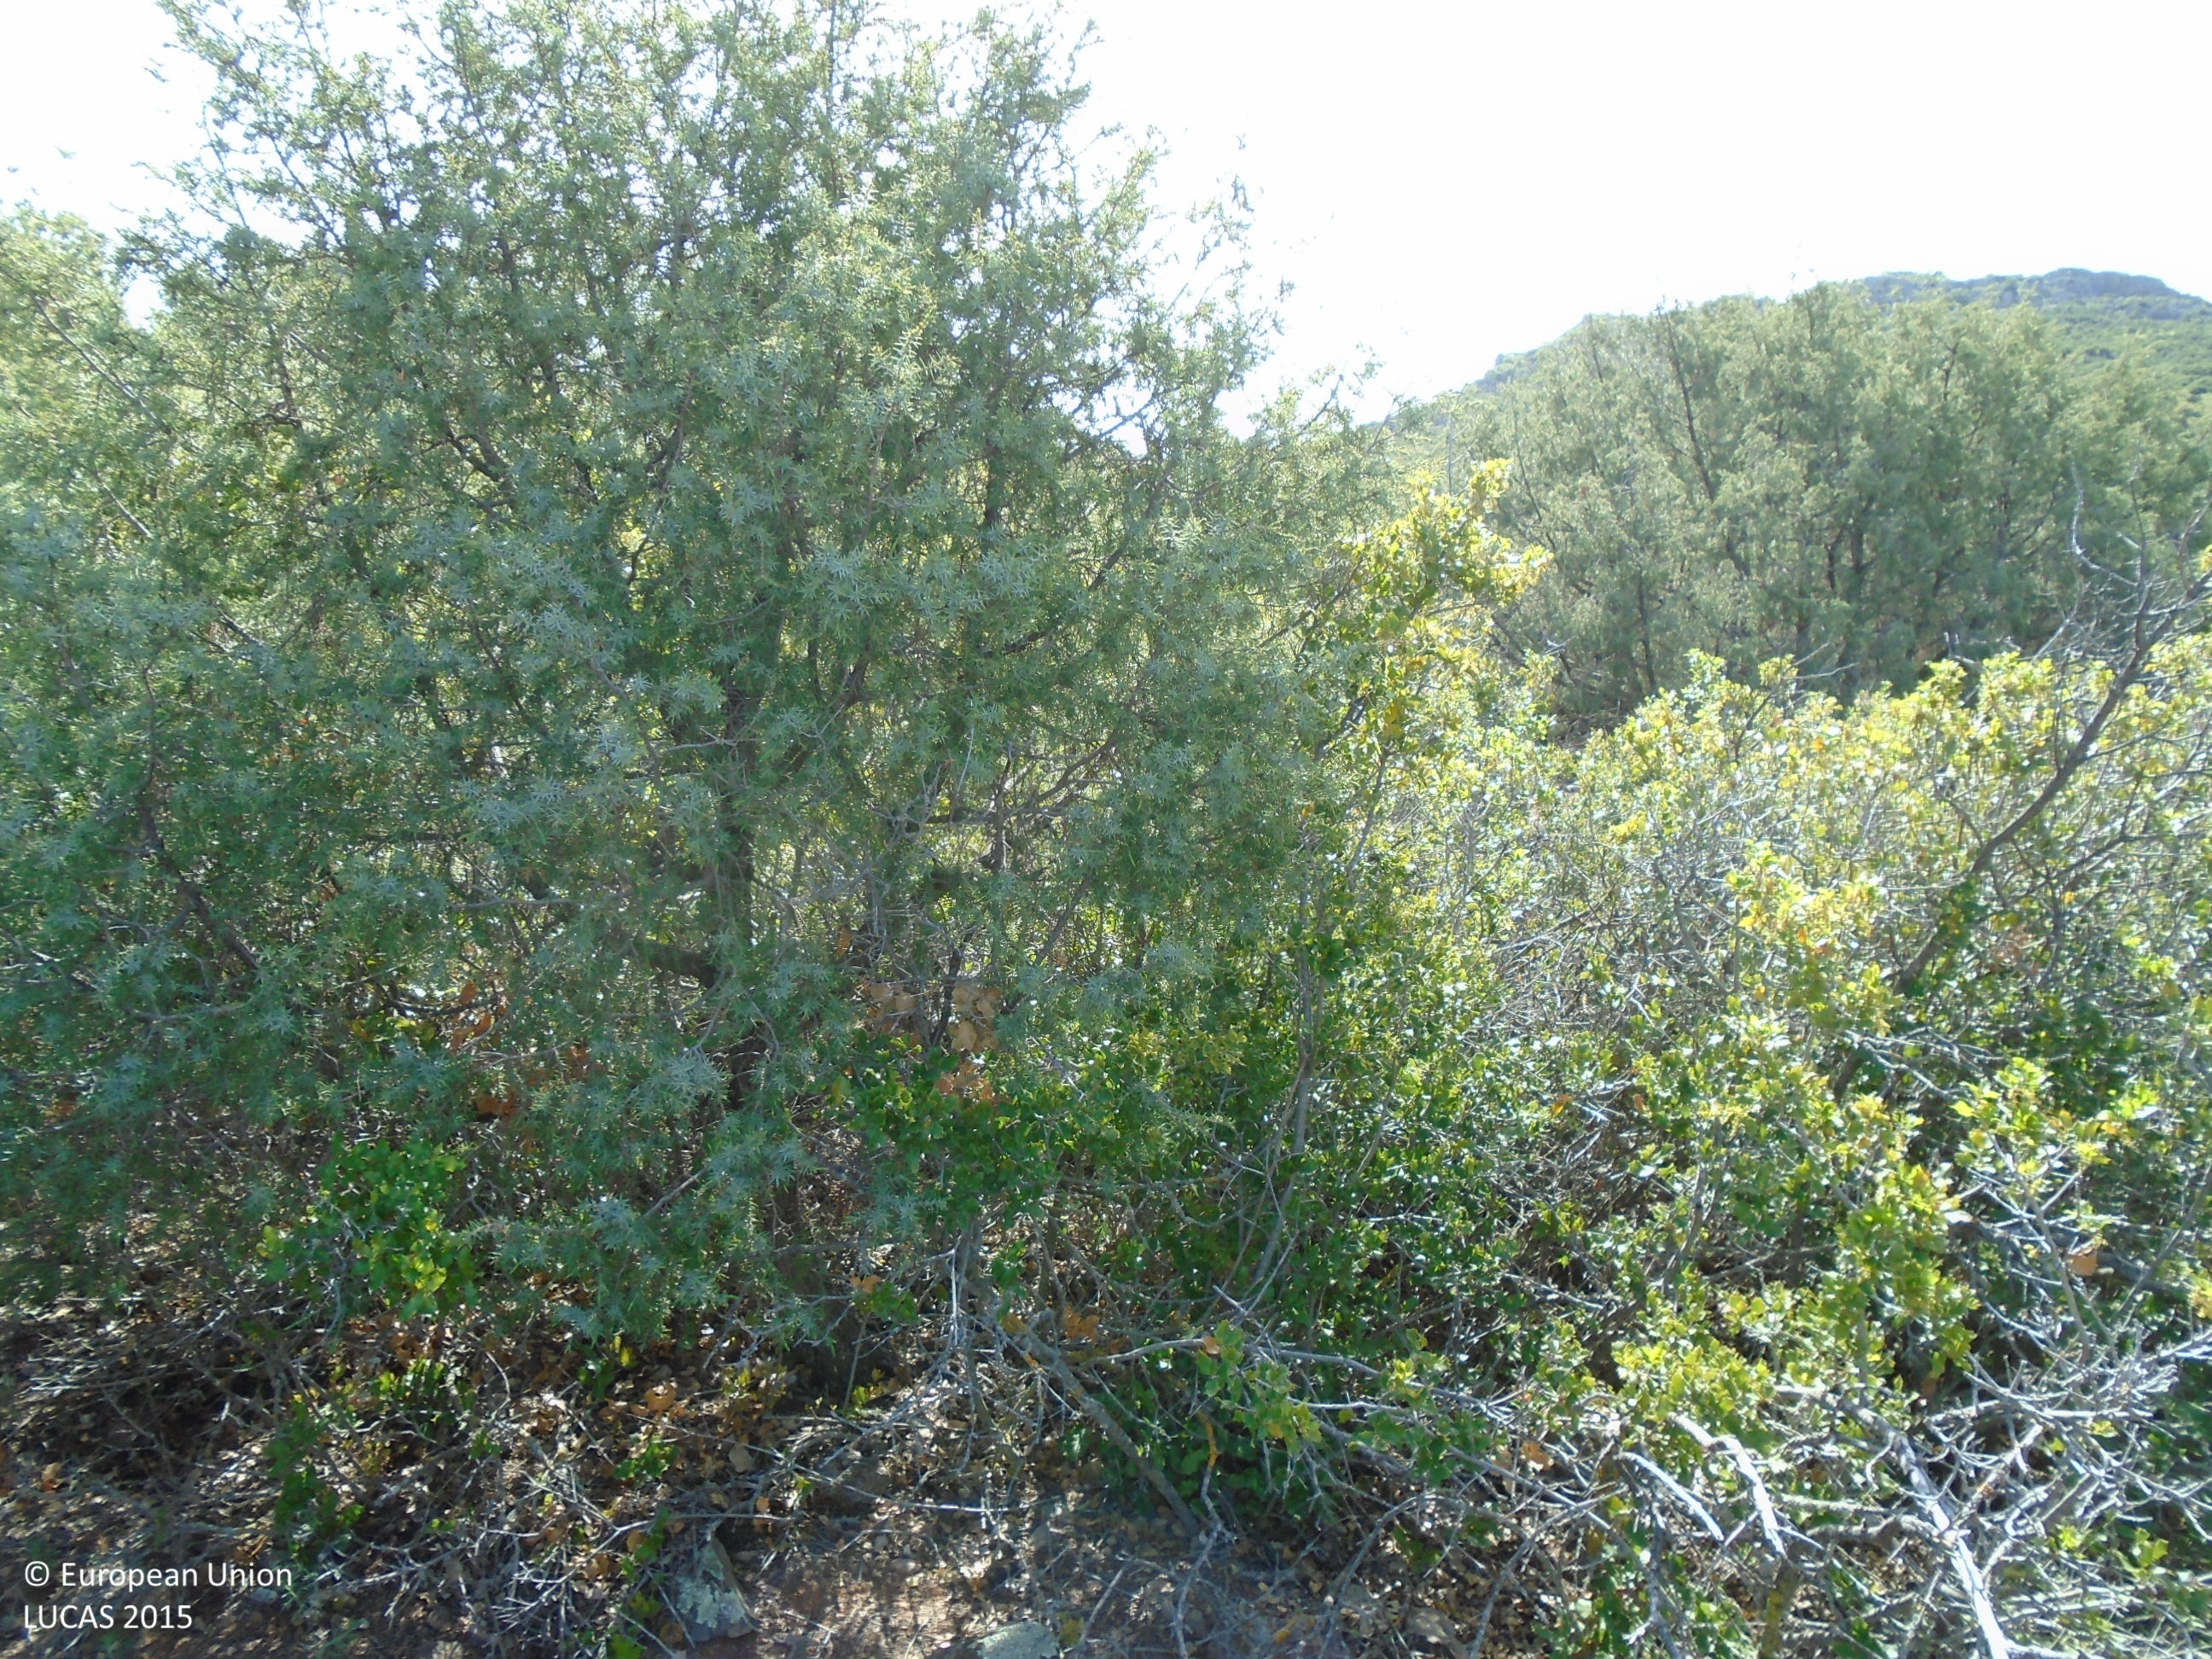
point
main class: Woodland
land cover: Broadleaved woodland
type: broadleaved evergreen forest
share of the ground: > 75 %
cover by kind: broadleaved forest trees 90 %, shrubs 10 %
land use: Semi-natural and natural areas not in use
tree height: > 5 m
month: May
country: ES
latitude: 39.6854
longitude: -3.7049
